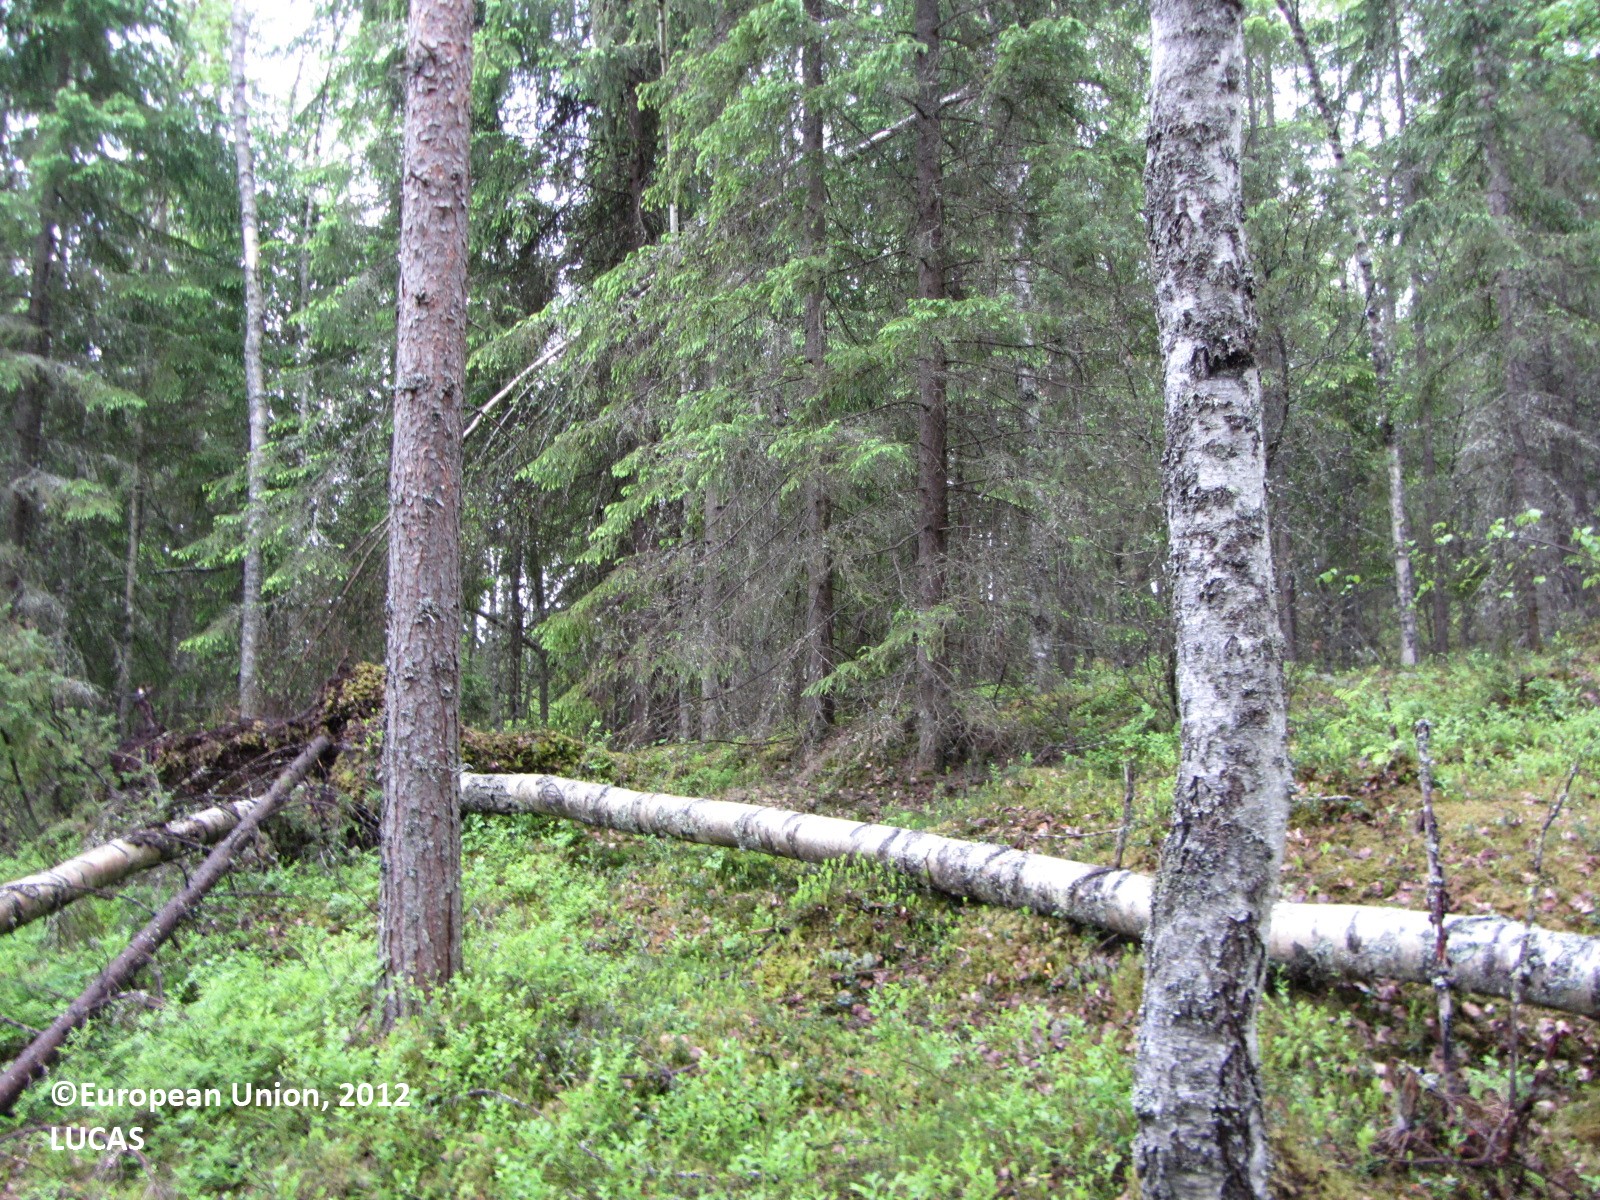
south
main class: Woodland
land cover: Spruce dominated mixed woodland
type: boreal forest
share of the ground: 50 - 75 %
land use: Forestry
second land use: Sport
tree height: > 5 m
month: June
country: FI
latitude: 61.8972
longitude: 25.1231
